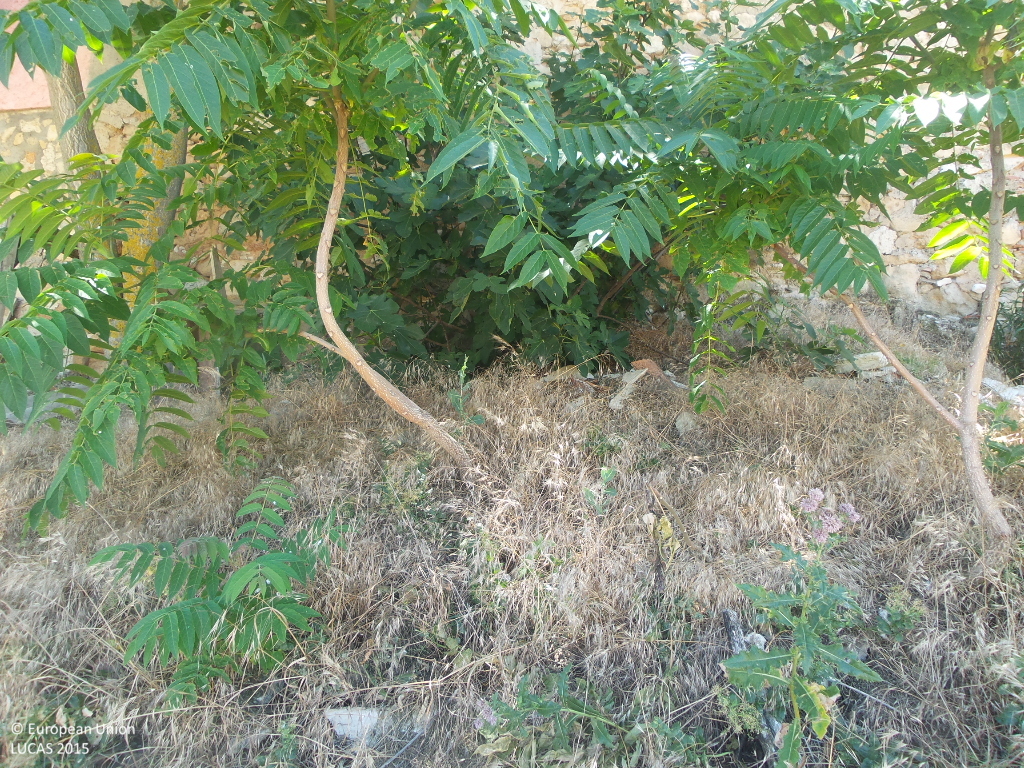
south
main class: Grassland
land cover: Grassland with sparse tree/shrub cover
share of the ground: > 75 %
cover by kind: herbaceous plants 95 %, broadleaved forest trees 5 %
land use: Semi-natural and natural areas not in use
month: July
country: ES
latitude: 41.4175
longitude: -2.0782
